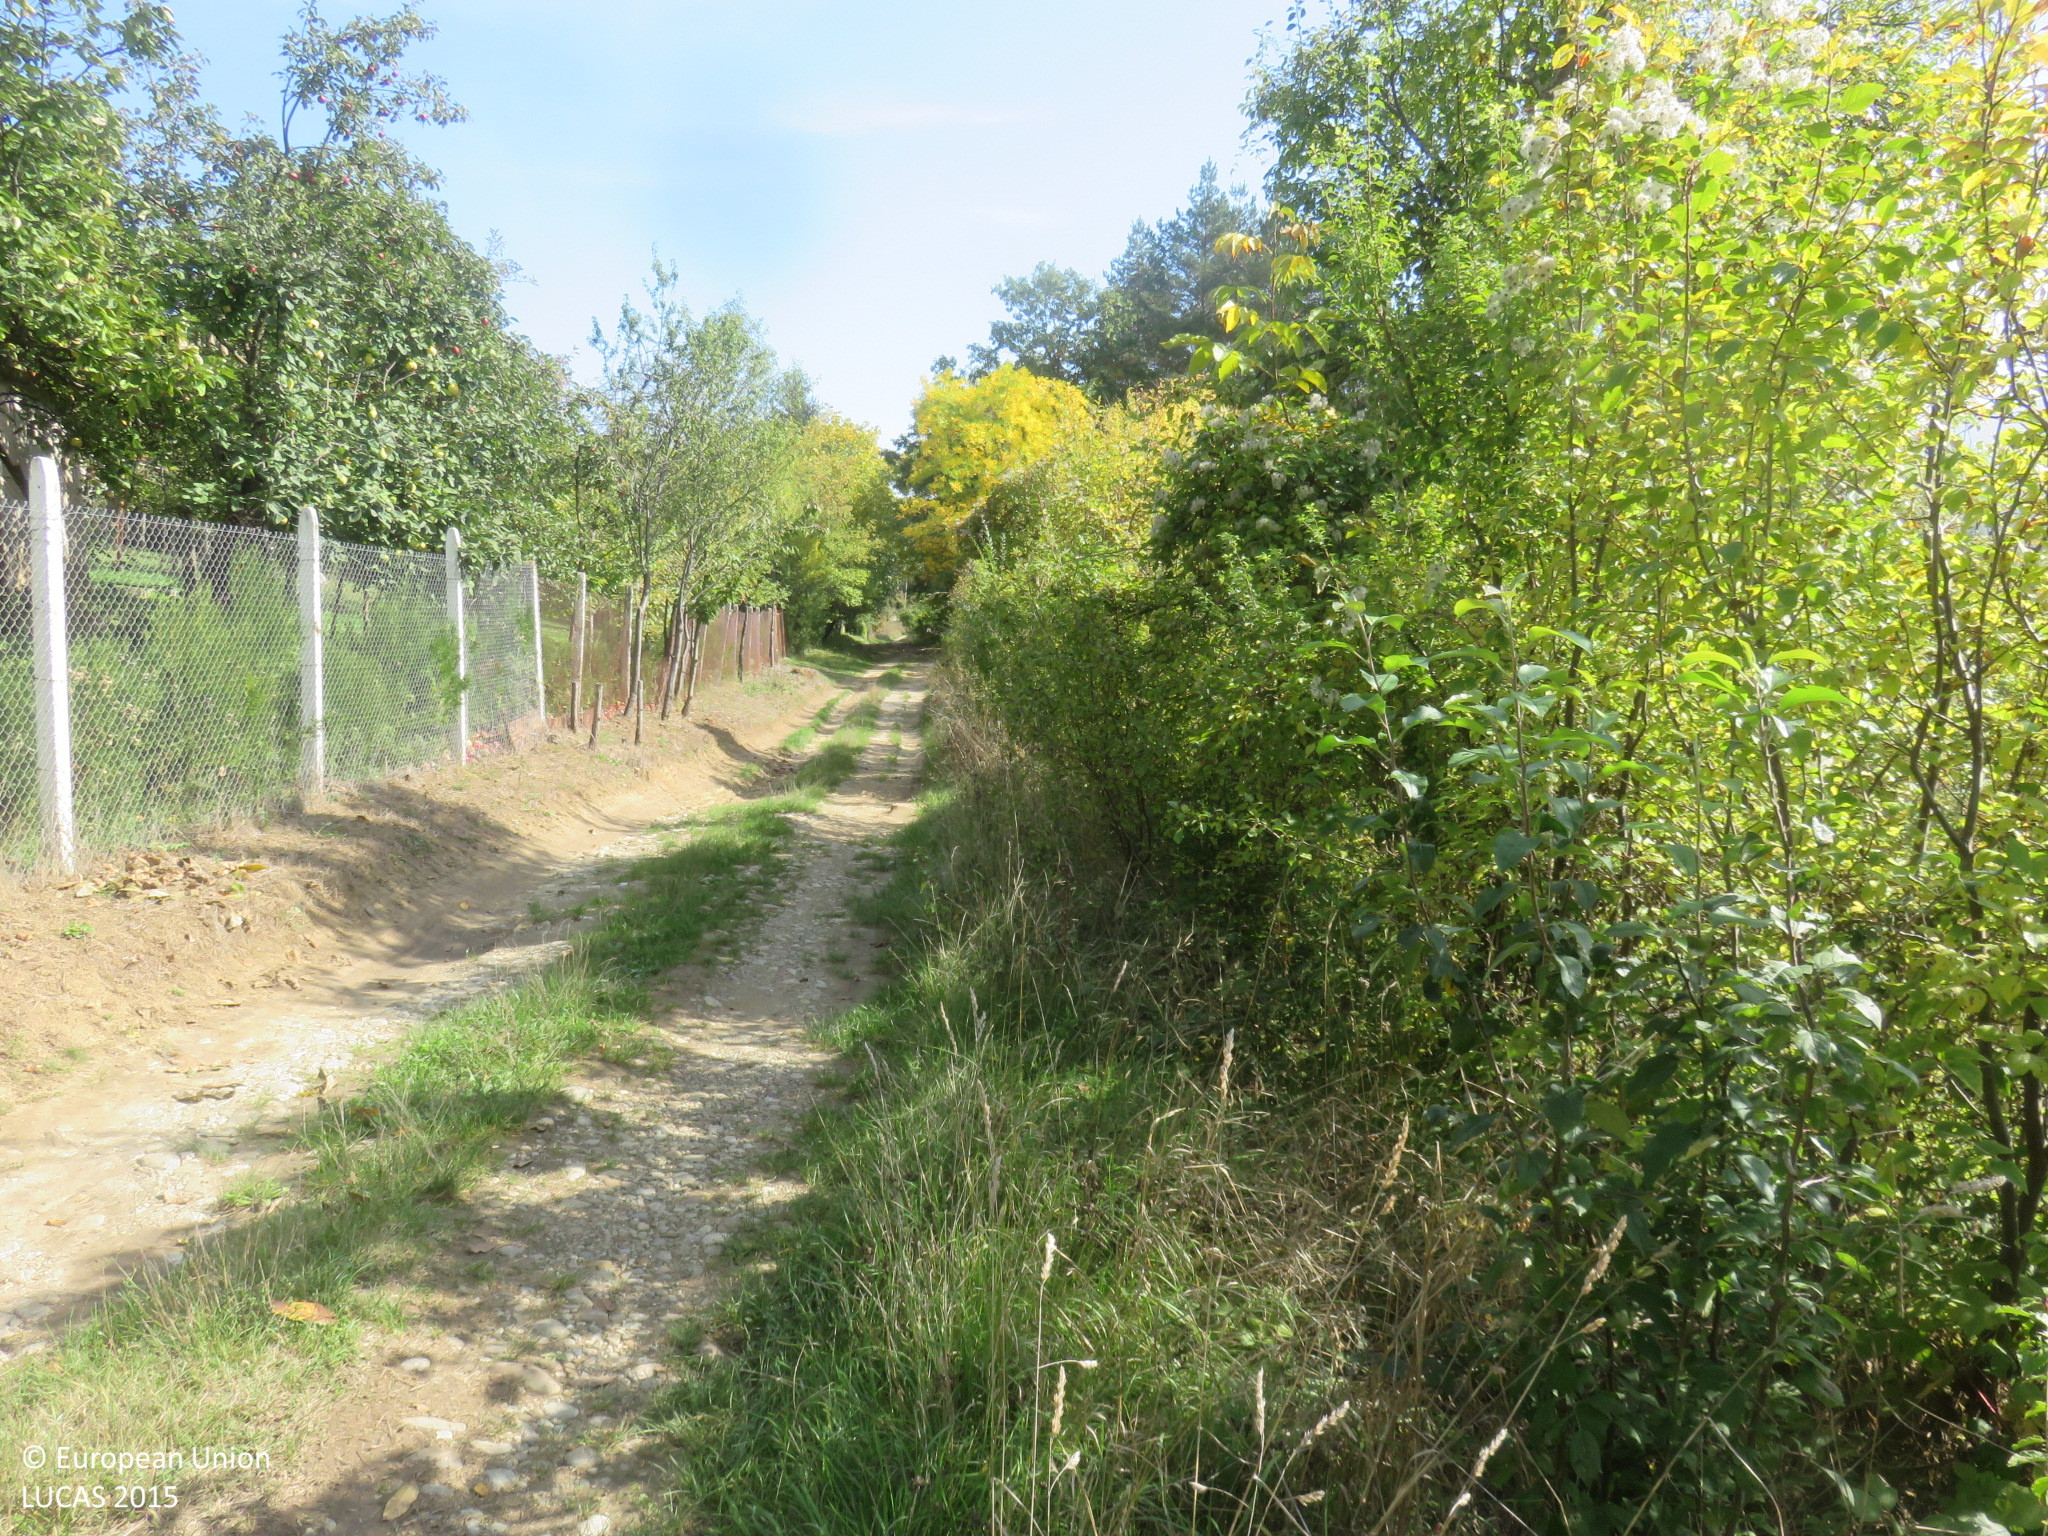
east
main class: Shrubland
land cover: Shrubland with sparse tree cover
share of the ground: 50 - 75 %
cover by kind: shrubs 75 %, herbaceous plants 20 %, broadleaved forest trees 5 %
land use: Residential
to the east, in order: Shrubland with sparse tree cover; Spontaneously vegetated surfaces; Broadleaved woodland; Artificial constructions in urban areas
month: October
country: BG
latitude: 42.9269
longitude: 24.8506
